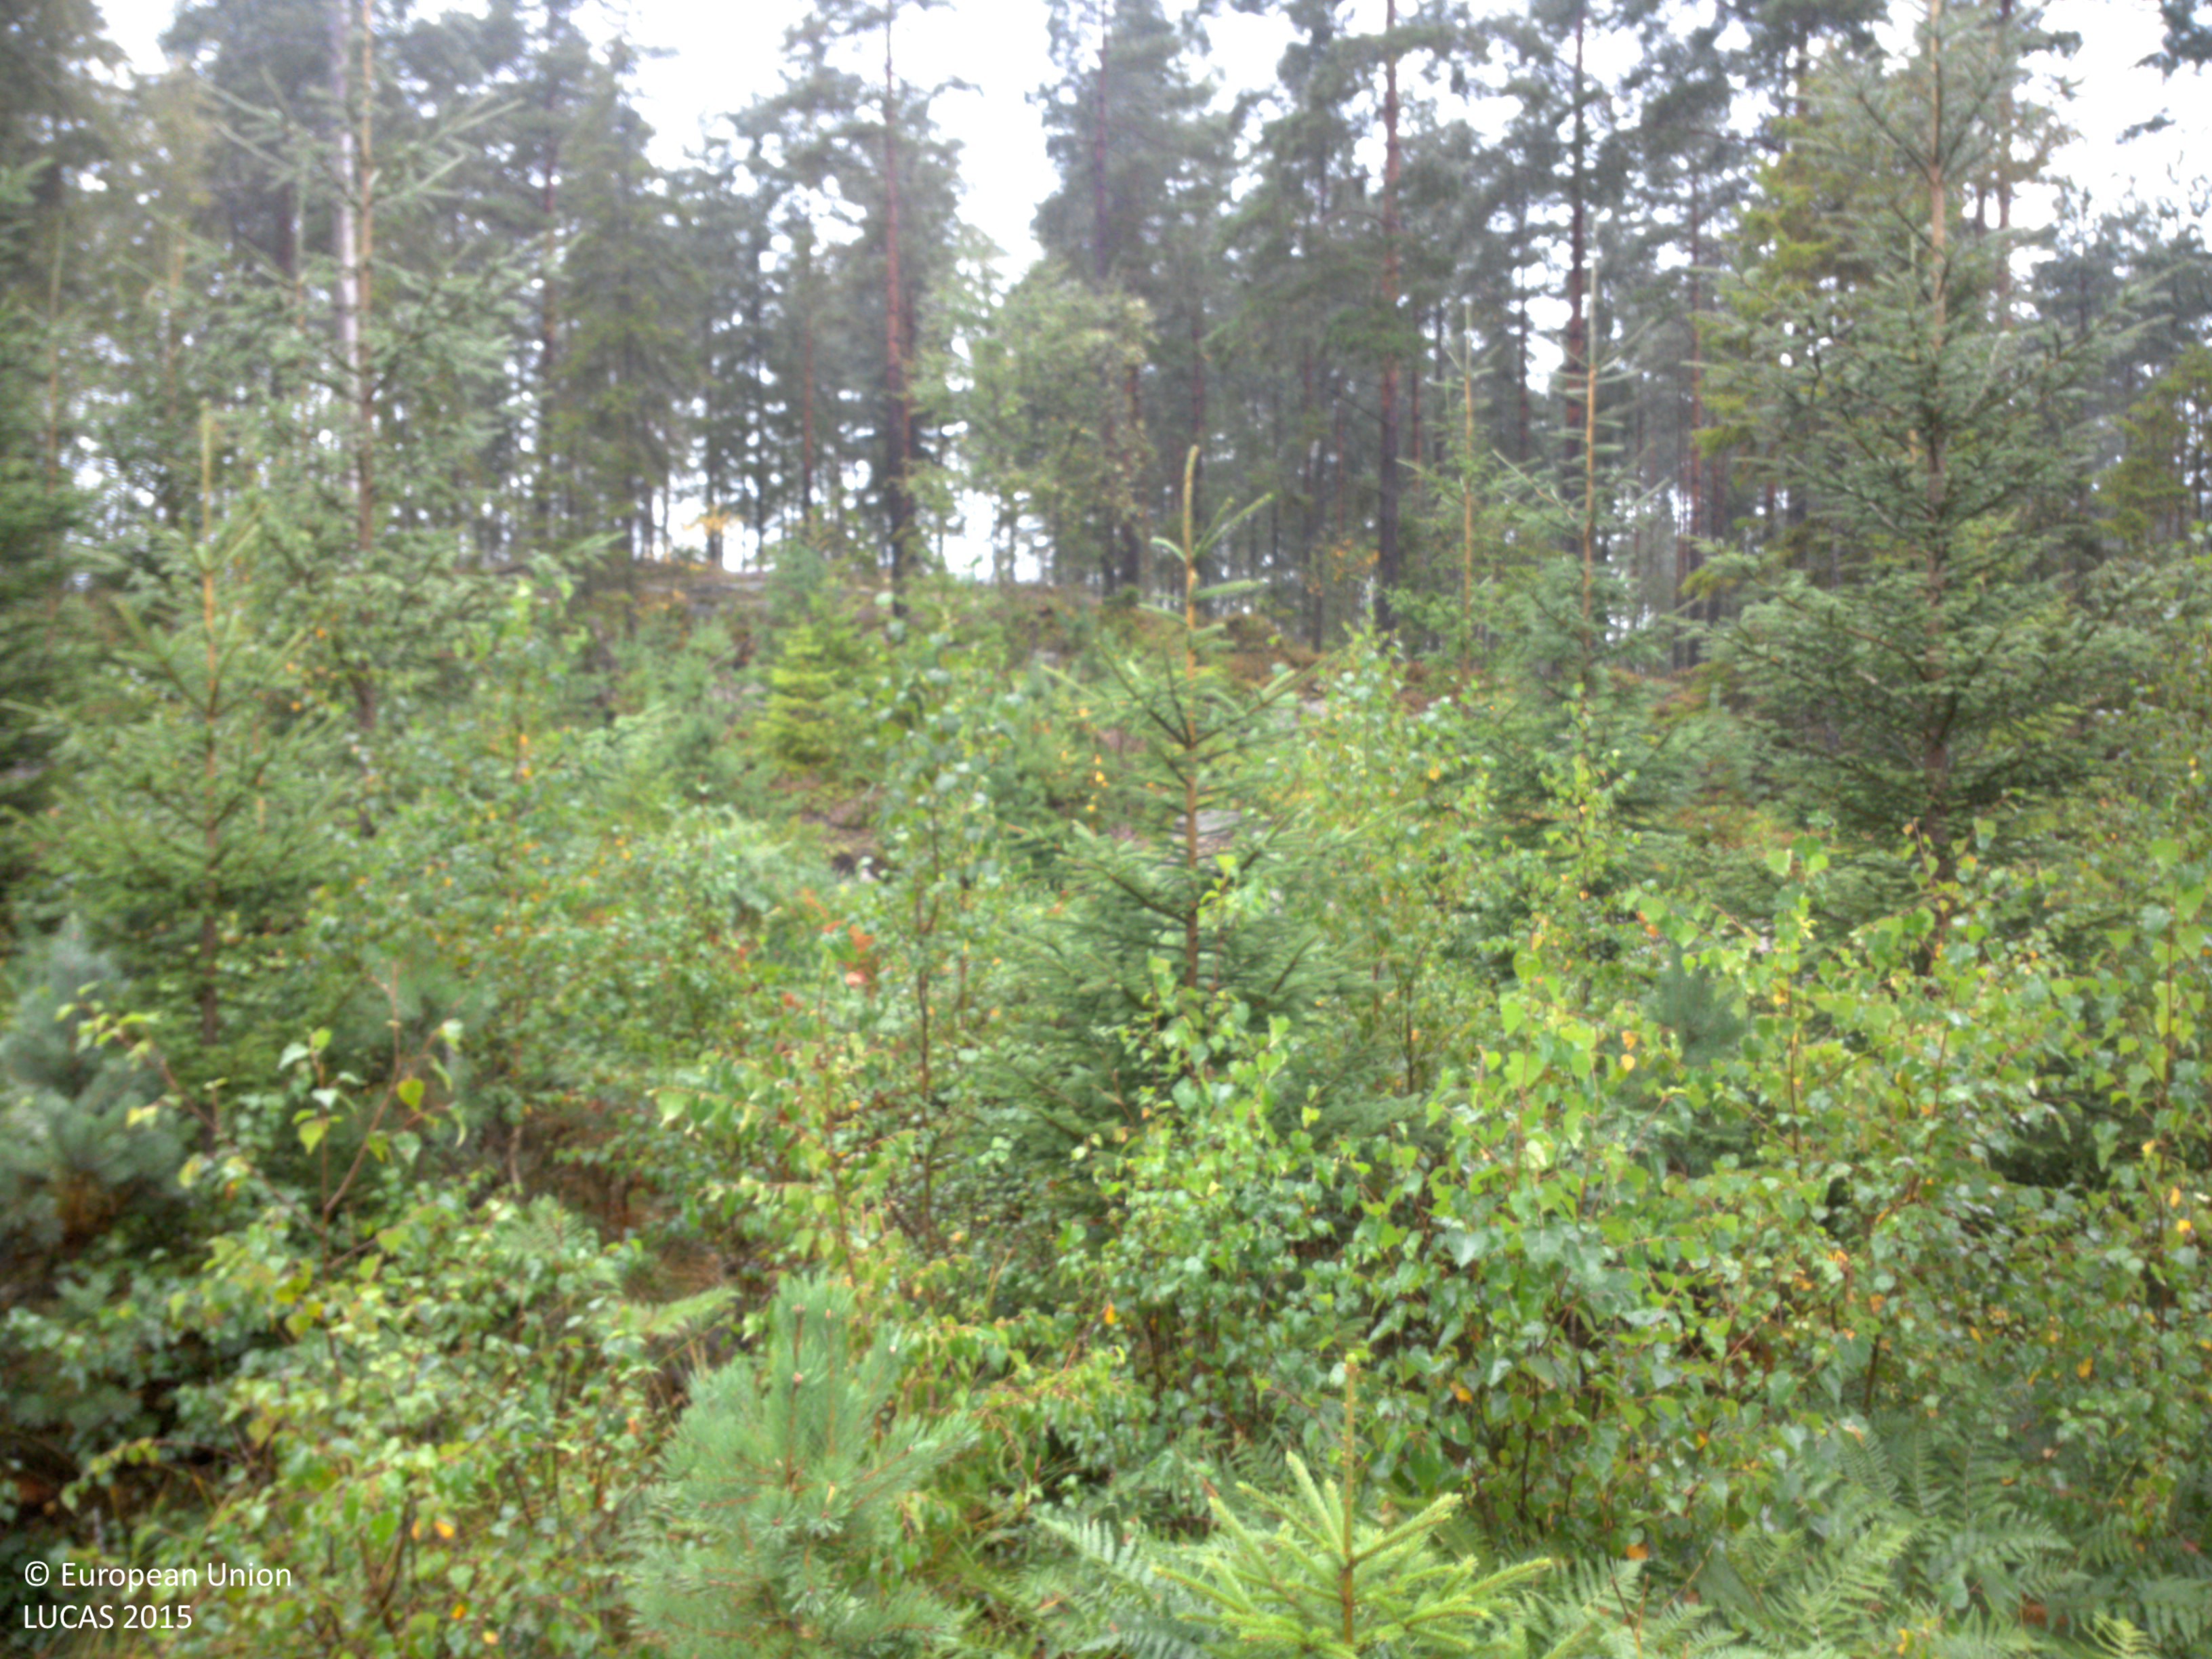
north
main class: Woodland
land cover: Spruce dominated mixed woodland
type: boreal forest
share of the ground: 50 - 75 %
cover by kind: coniferous forest trees 50 %, broadleaved forest trees 20 %, shrubs 15 %, herbaceous plants 10 %, lichens and mosses 5 %
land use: Forestry
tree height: < 5 m
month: August
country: SE
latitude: 58.0735
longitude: 12.3185
